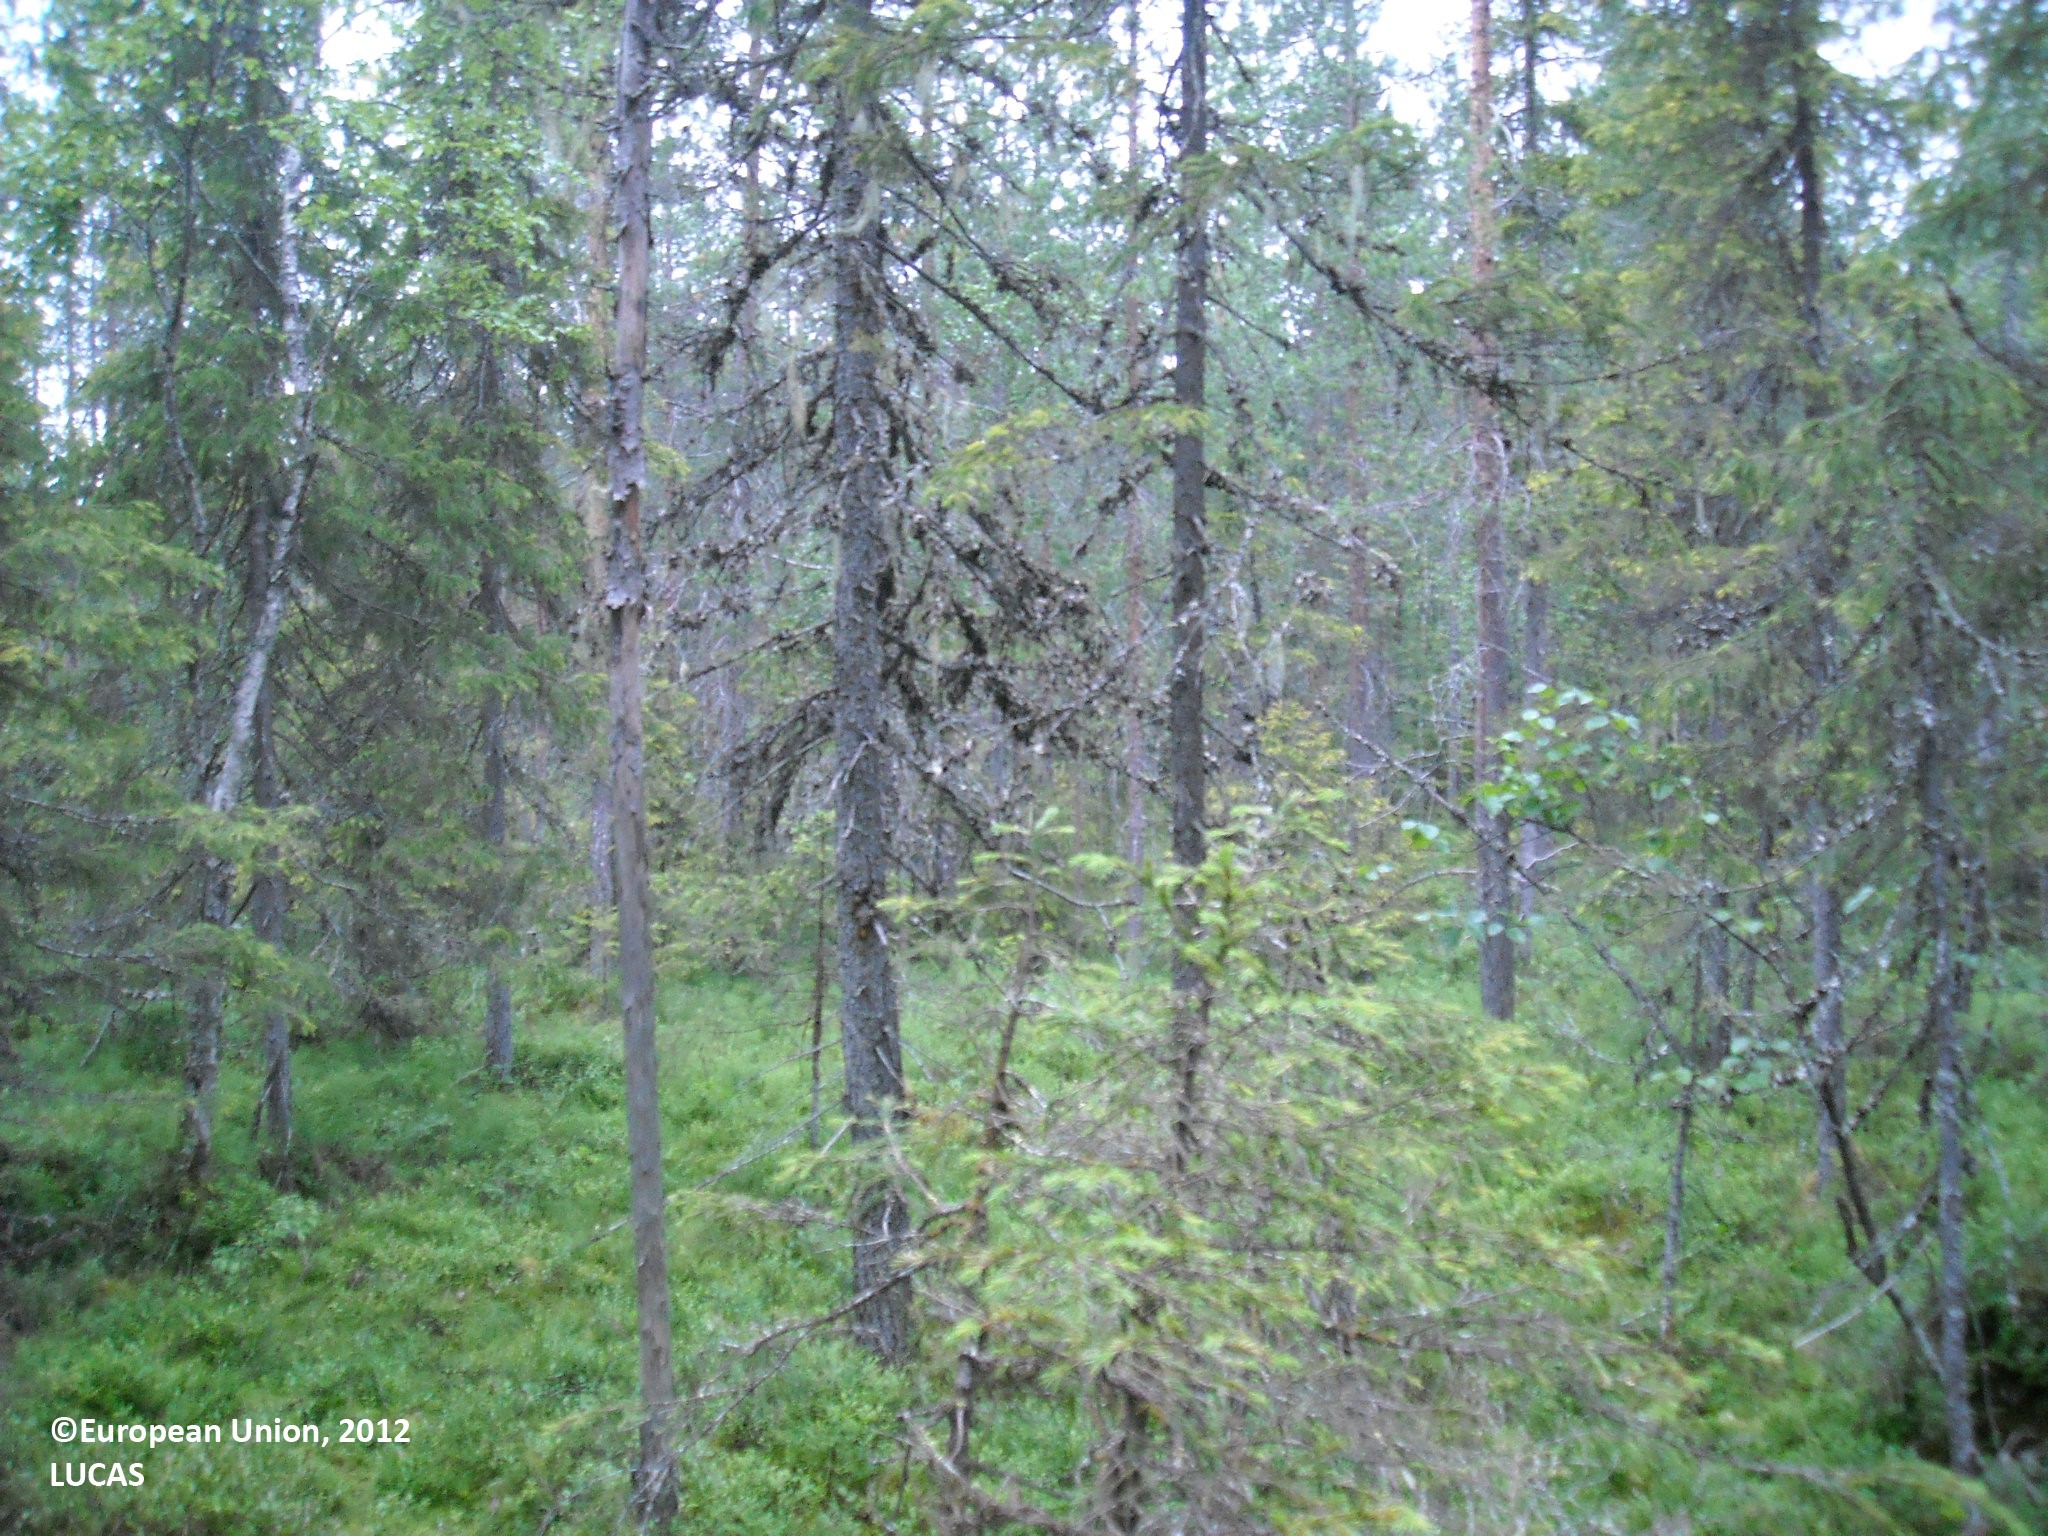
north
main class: Woodland
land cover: Other coniferous woodland
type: boreal forest
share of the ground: > 75 %
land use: Semi-natural and natural areas not in use
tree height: > 5 m
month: July
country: FI
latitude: 65.0223
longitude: 26.7326
